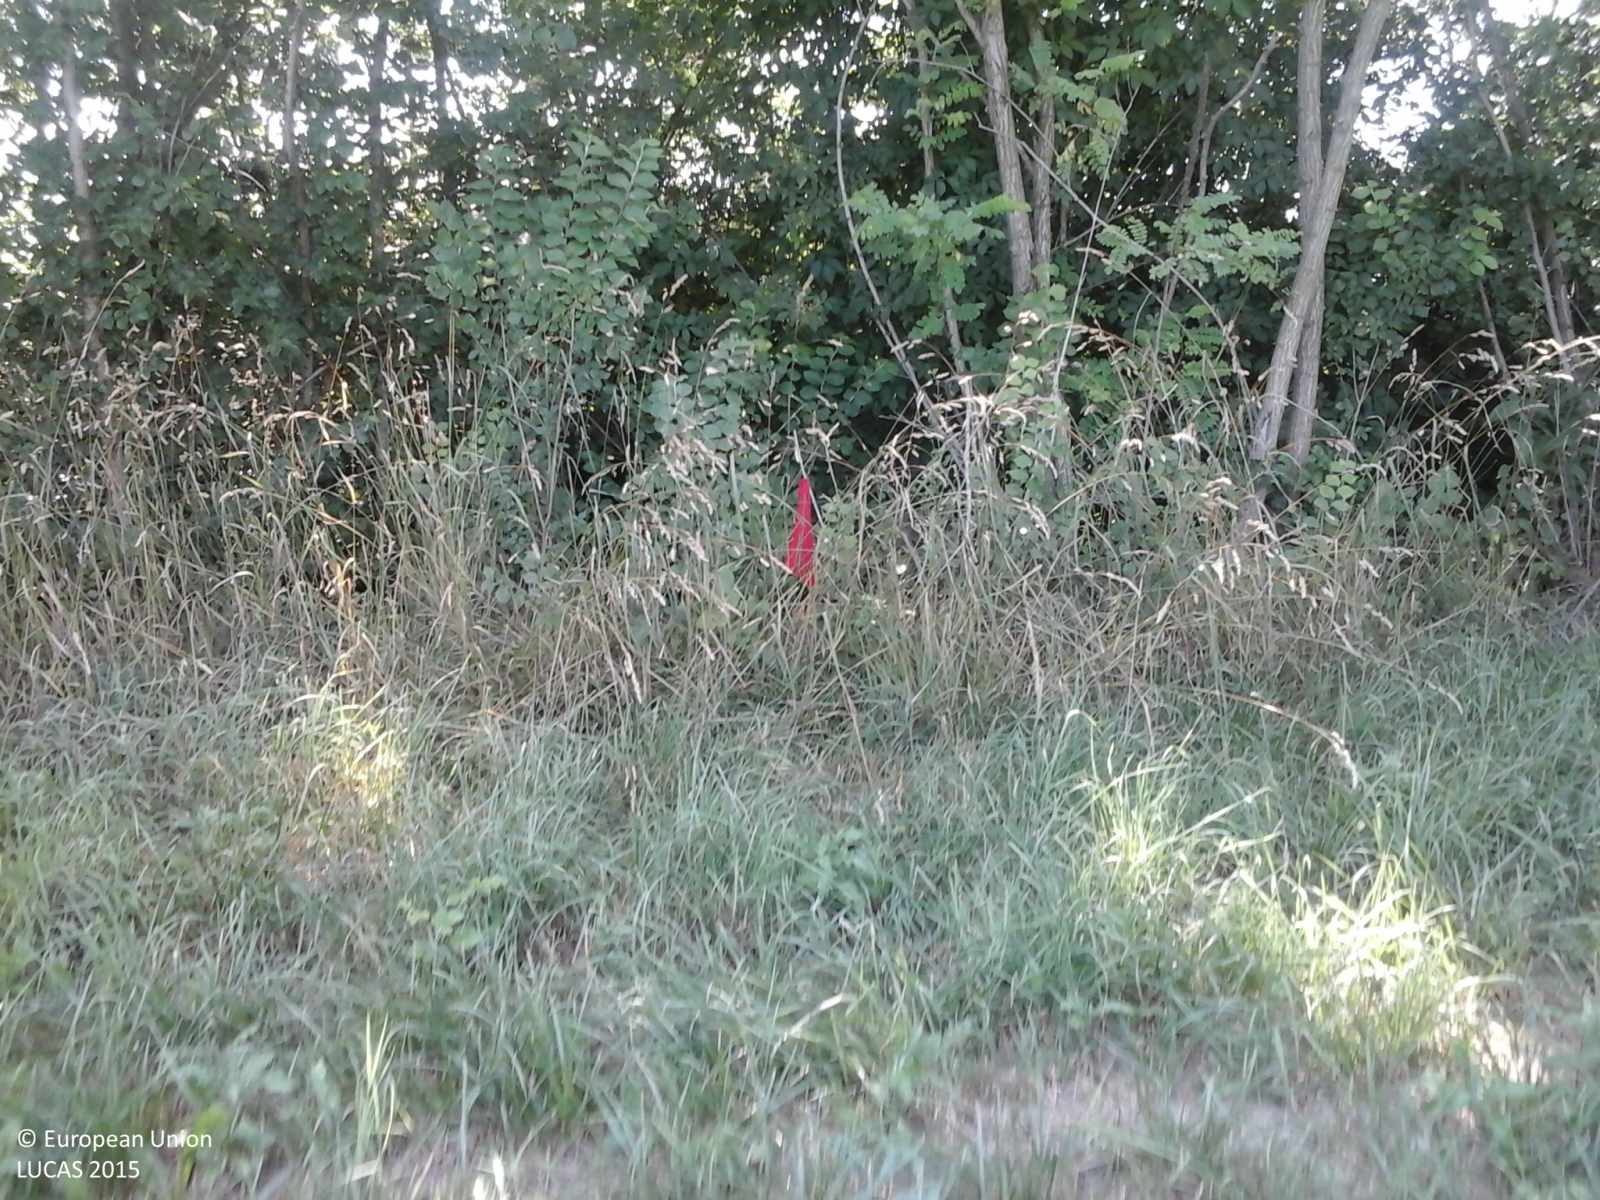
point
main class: Grassland
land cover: Grassland without tree/shrub cover
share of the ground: > 75 %
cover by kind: herbaceous plants 100 %
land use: Agriculture (excluding fallow land and kitchen gardens)
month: June
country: IT
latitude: 45.0025
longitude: 8.2145
